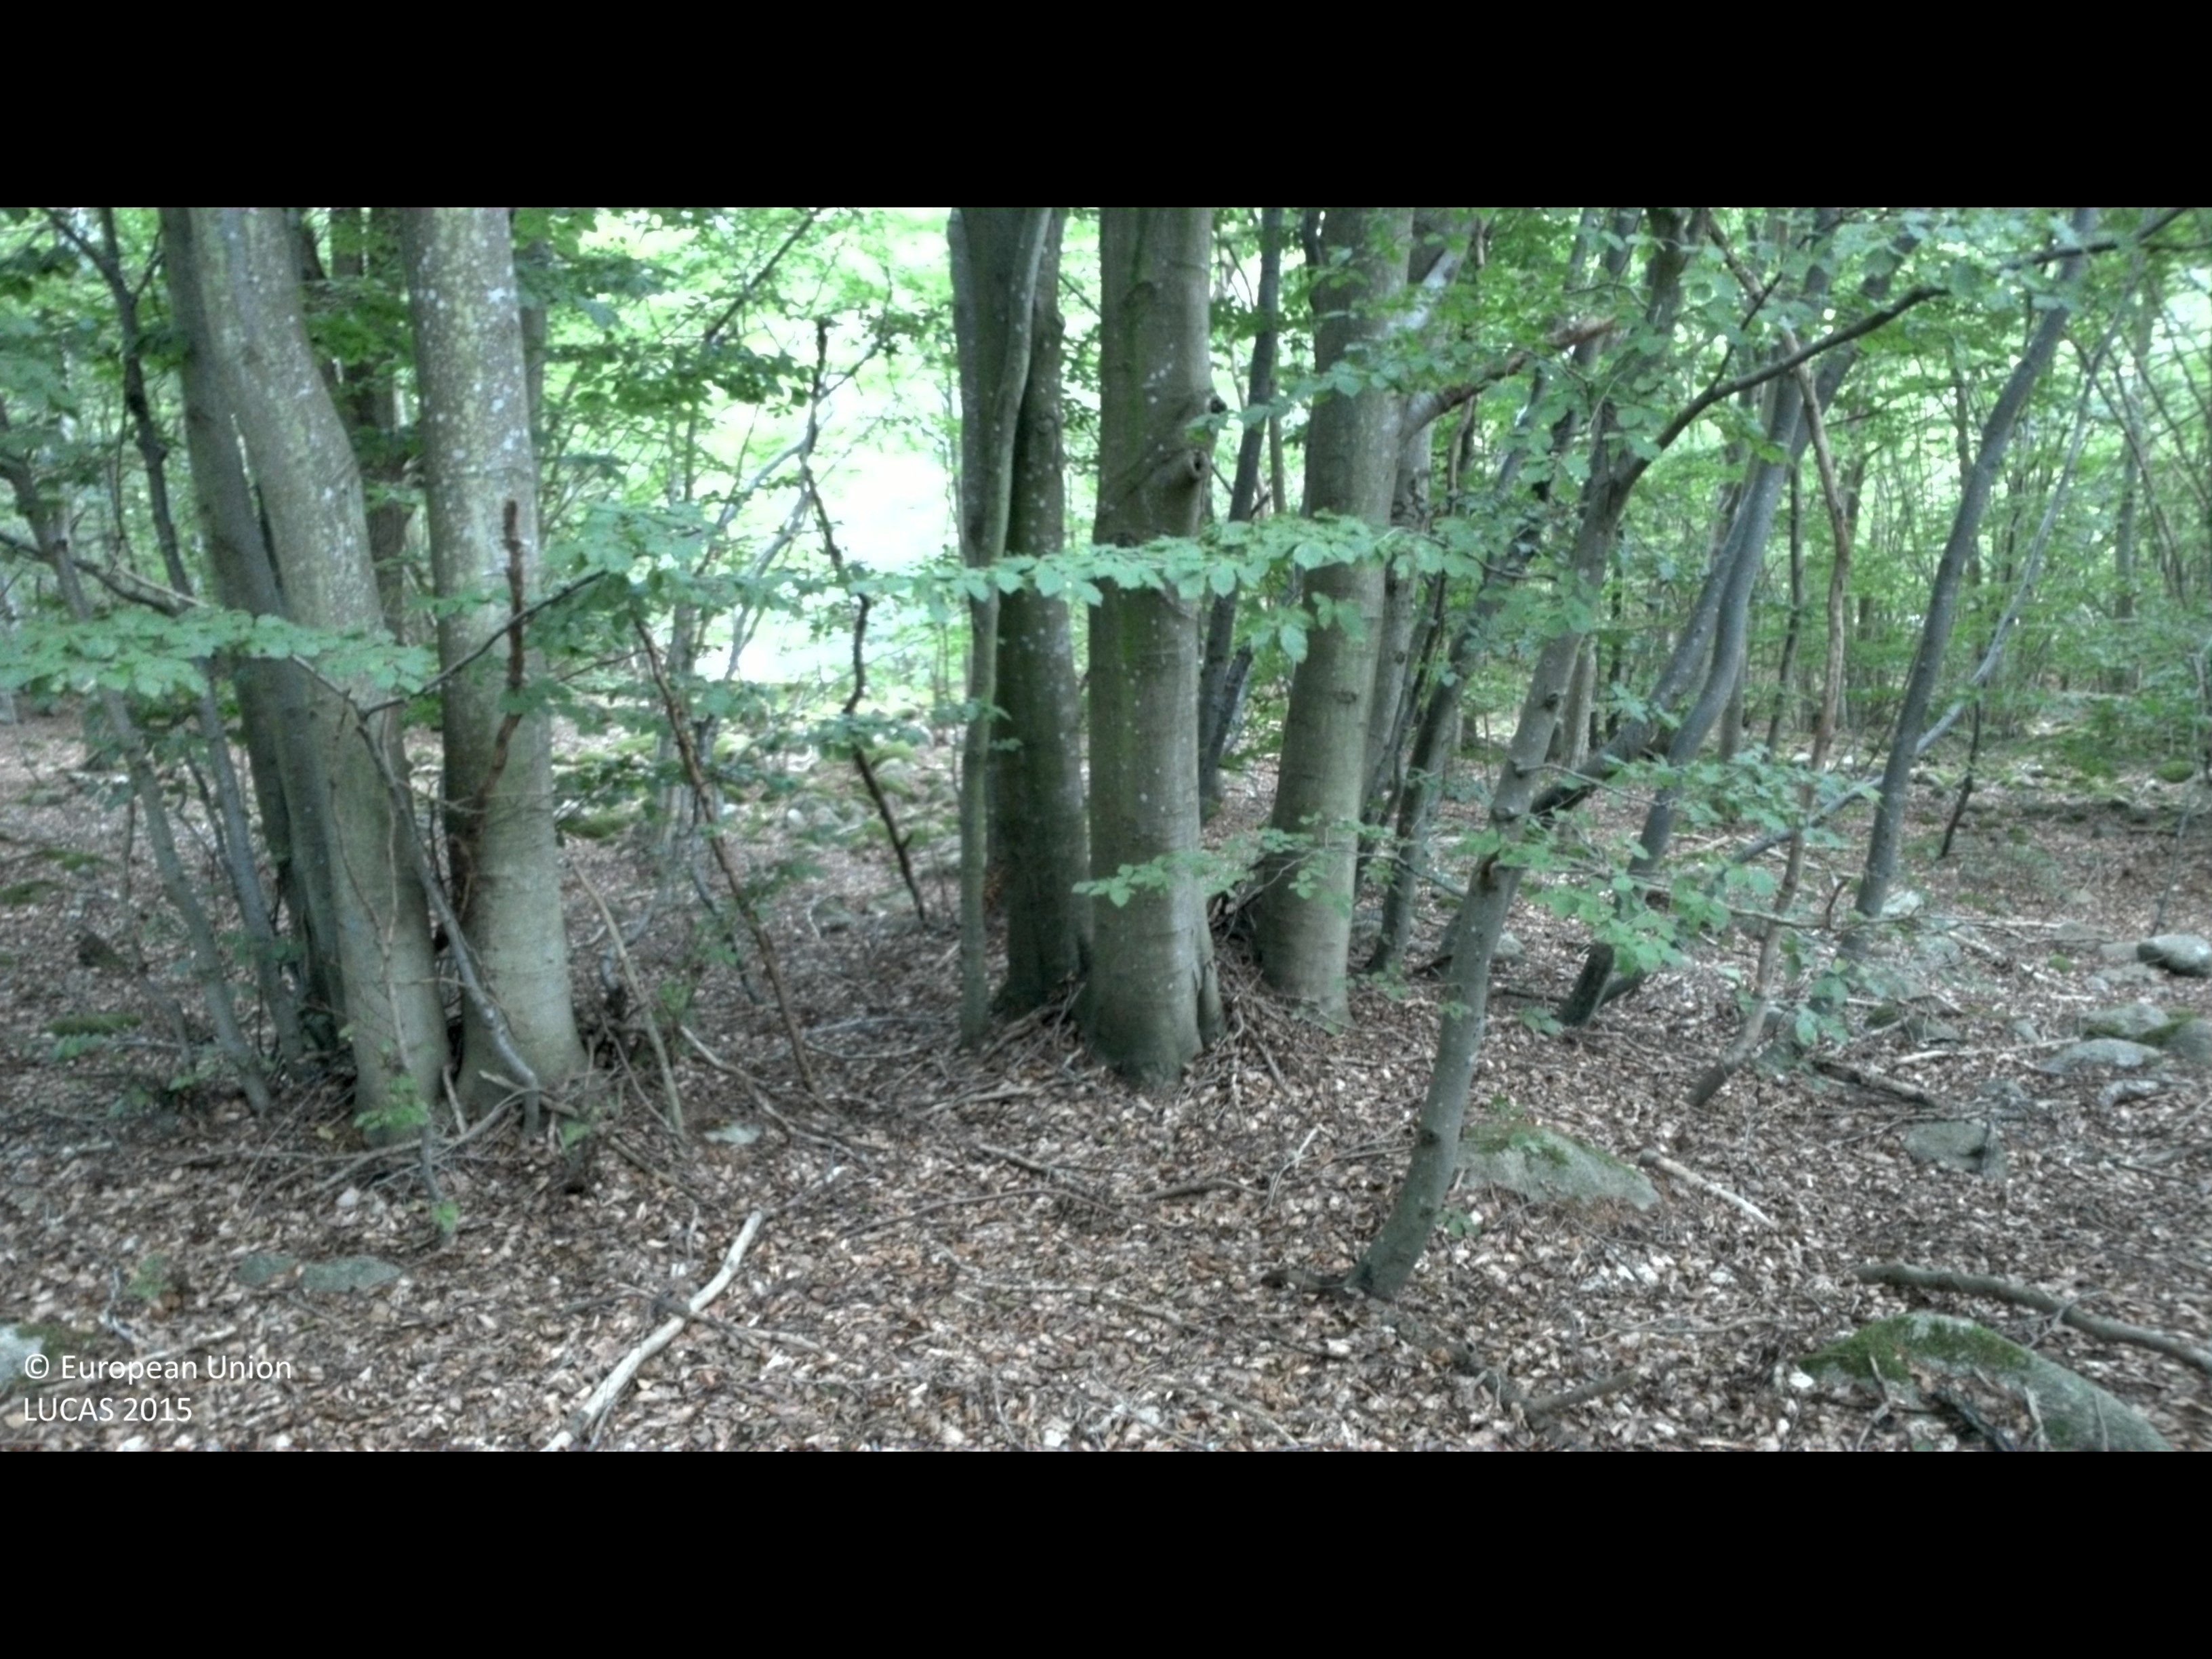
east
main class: Woodland
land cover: Broadleaved woodland
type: beech forest
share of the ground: > 75 %
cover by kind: broadleaved forest trees 75 %, consolidated bare surface 5 %
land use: Amenities, museums, leisure
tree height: > 5 m
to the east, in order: Broadleaved woodland; Dry stone walls; Broadleaved woodland; Rocks and stones; Tracks; Rocks and stones
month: September
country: SE
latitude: 56.0273
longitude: 14.7643
